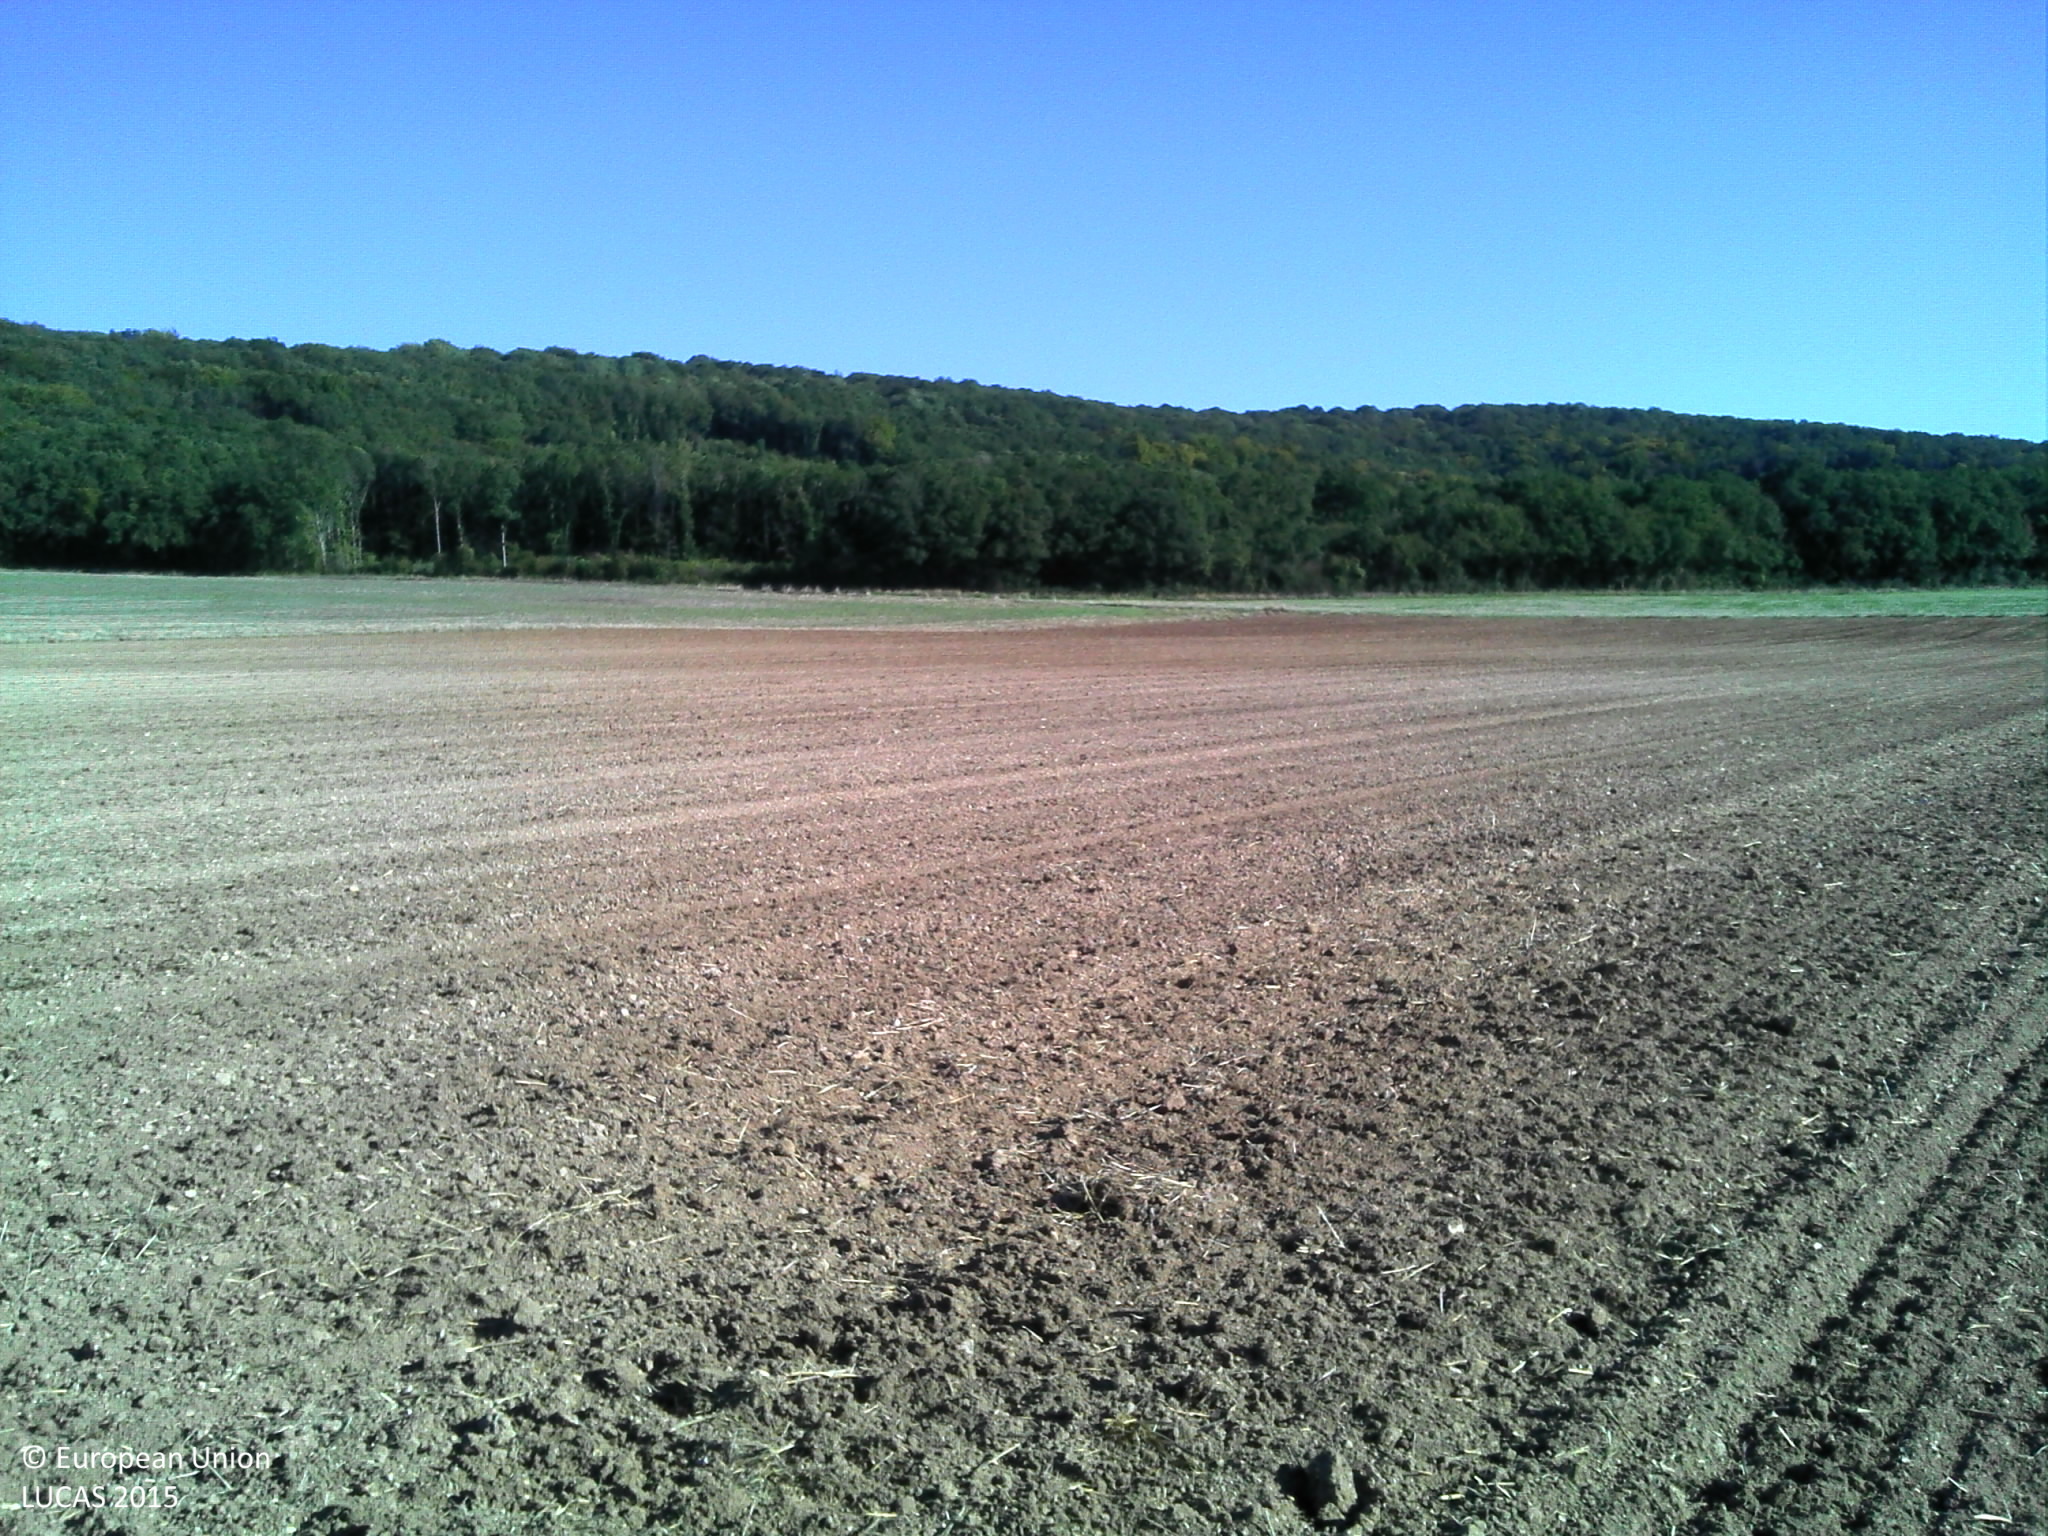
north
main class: Cropland
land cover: Common wheat
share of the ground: 10 - 25 %
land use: Agriculture (excluding fallow land and kitchen gardens)
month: September
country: FR
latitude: 48.0855
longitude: 3.8071
